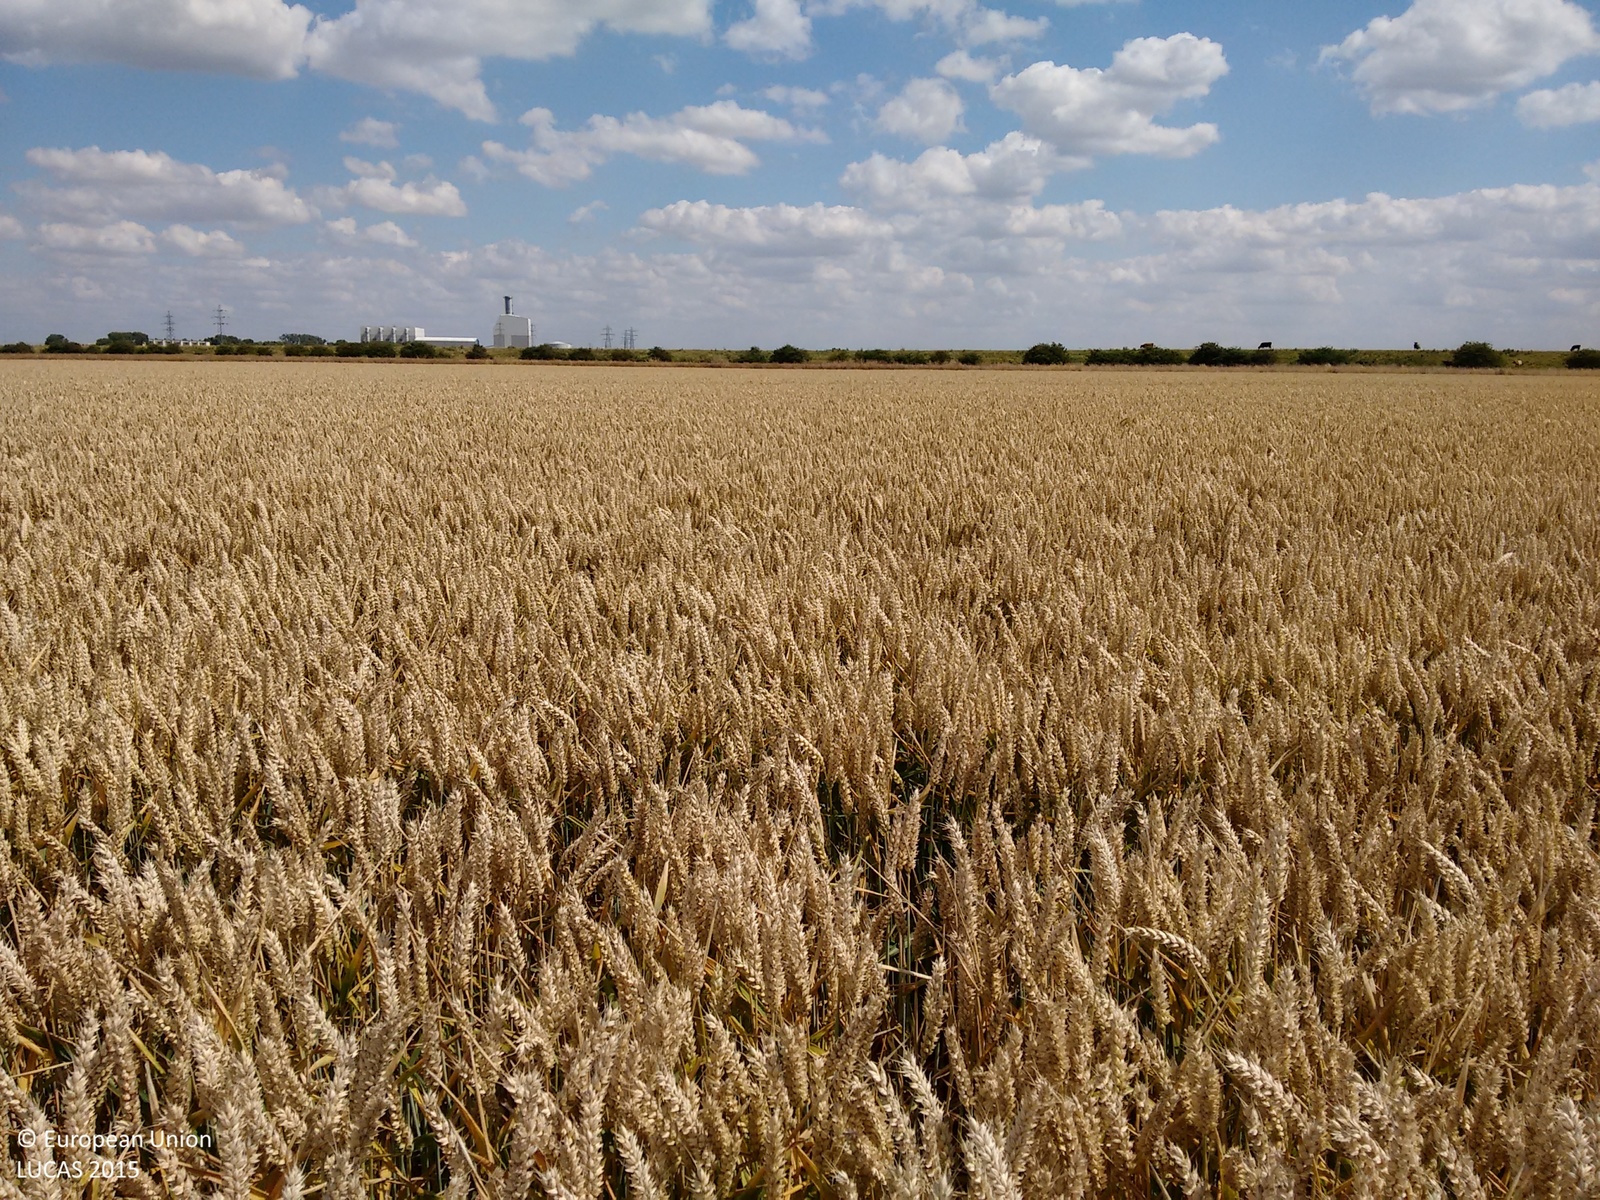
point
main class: Cropland
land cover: Common wheat
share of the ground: > 75 %
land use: Agriculture (excluding fallow land and kitchen gardens)
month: July
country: GB
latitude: 52.7269
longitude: 0.3614
